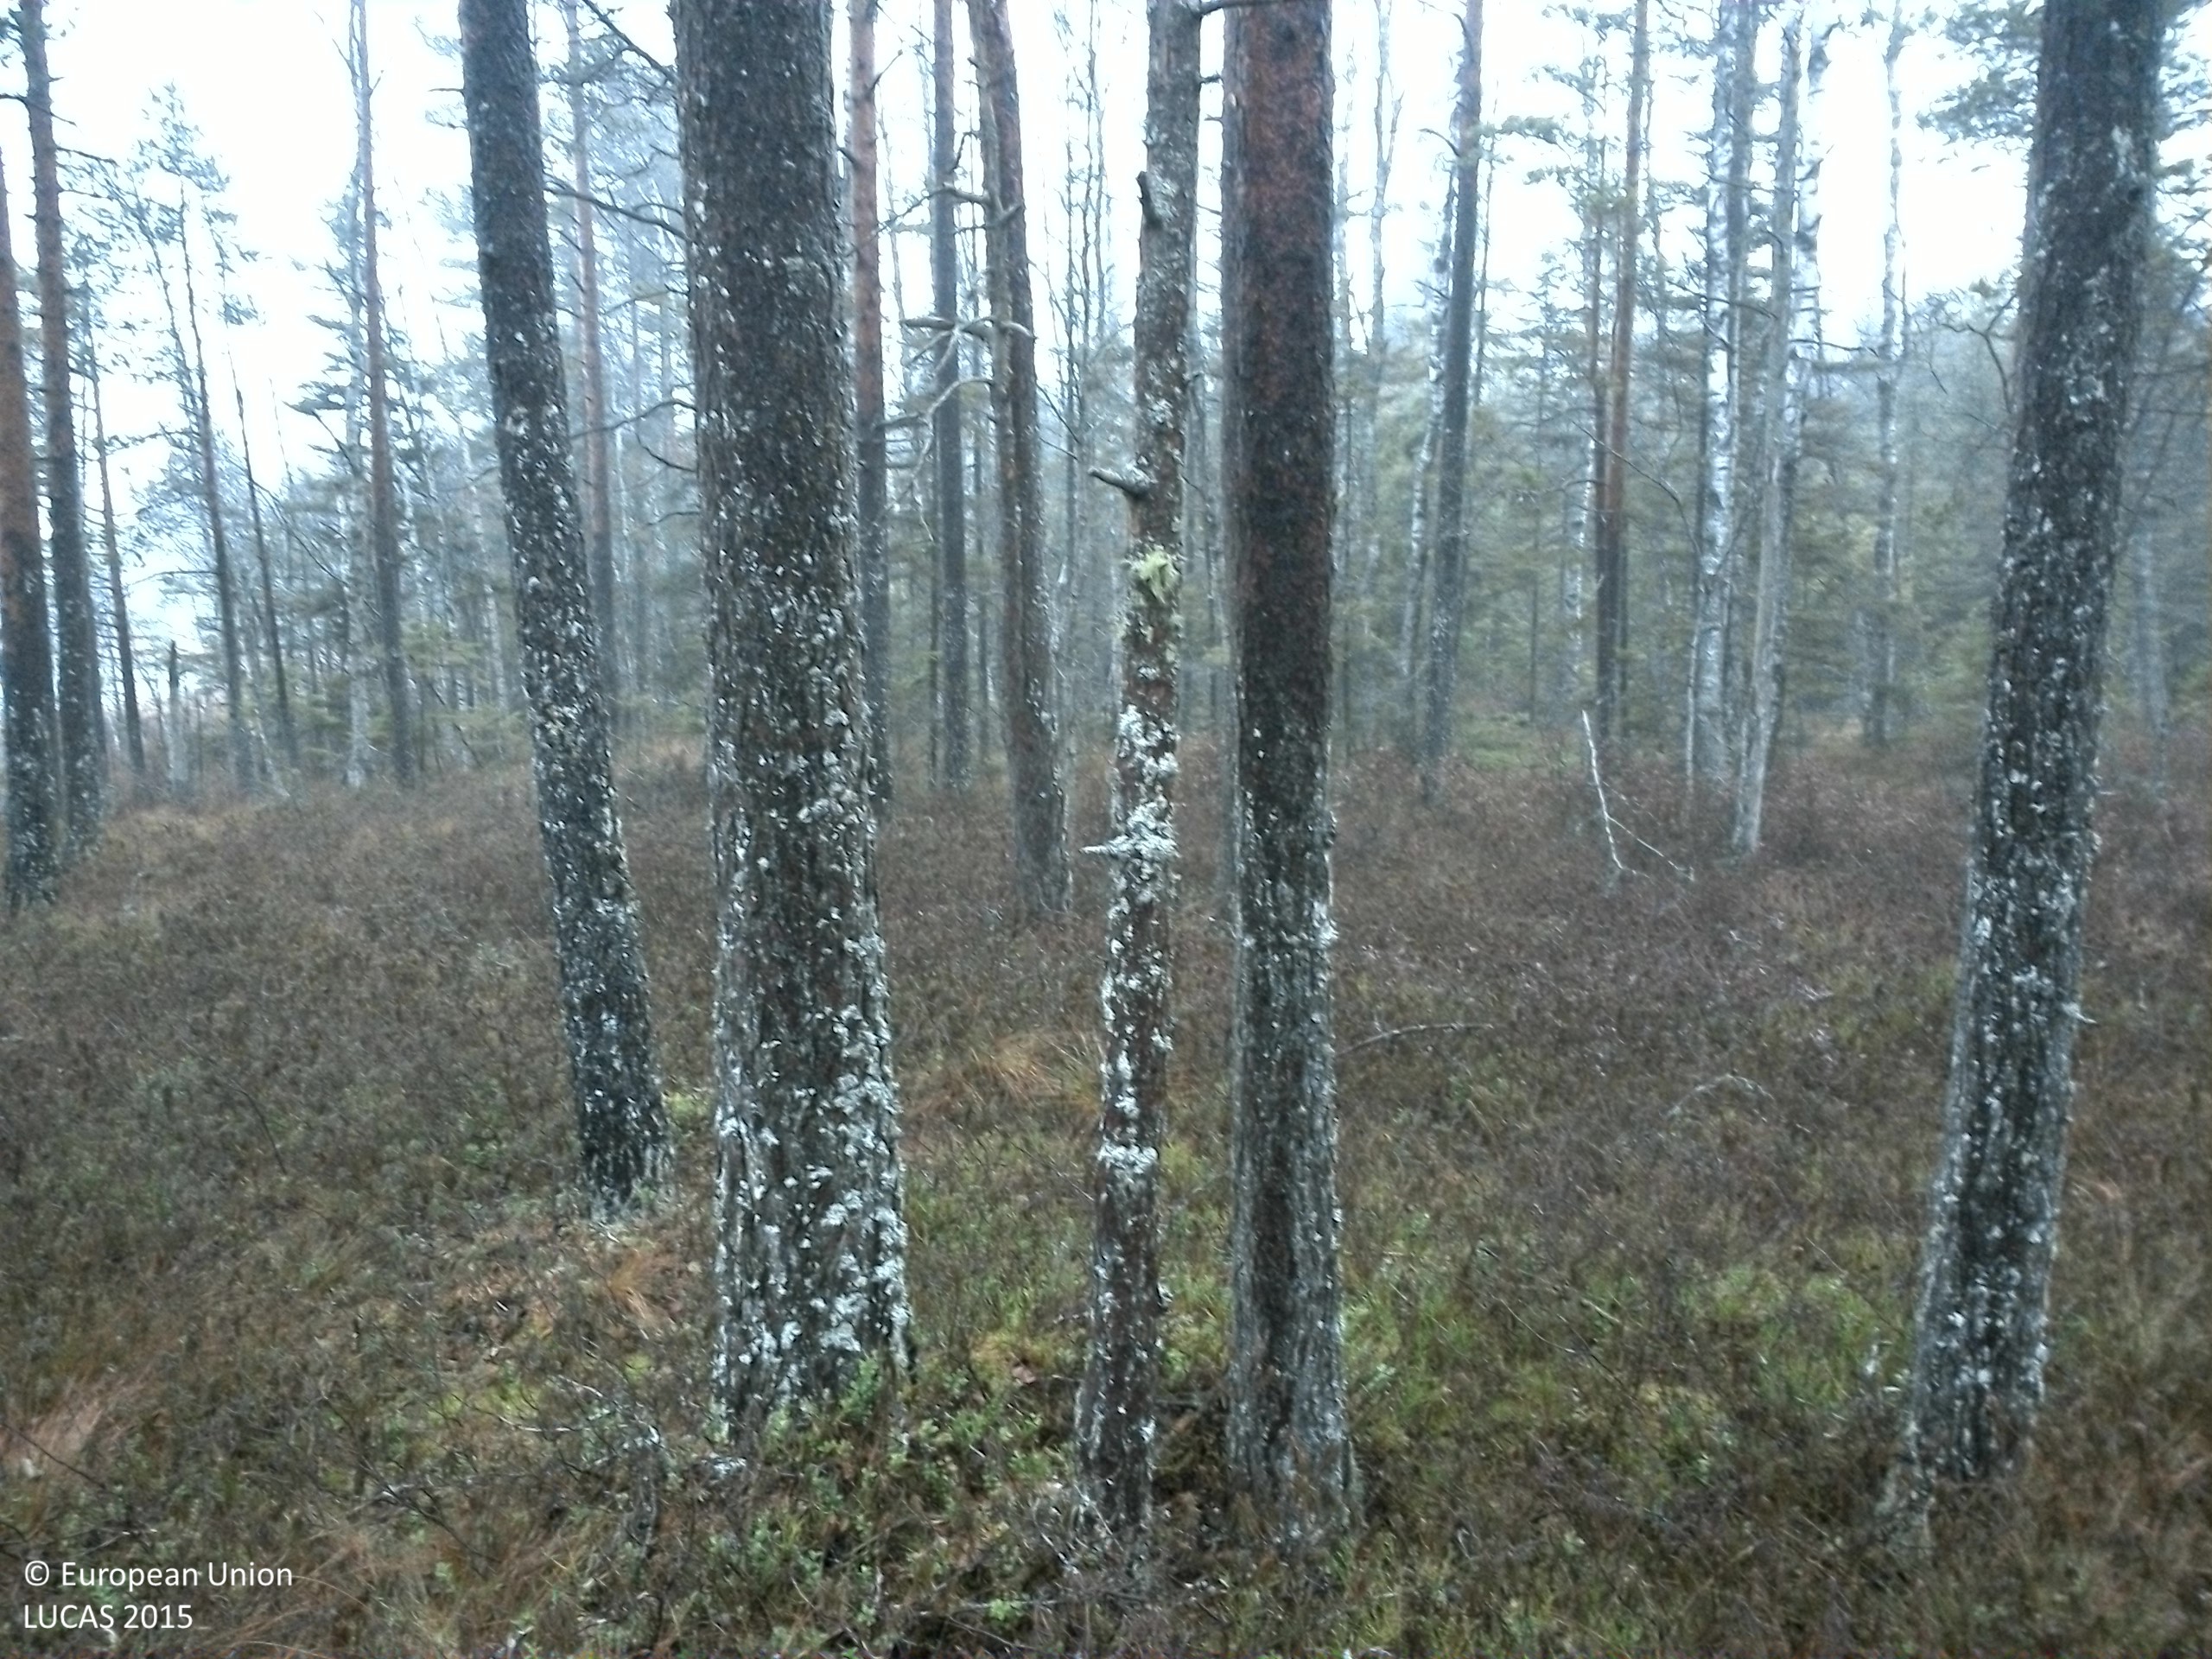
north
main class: Woodland
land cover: Pine dominated coniferous woodland
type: mire and swamp forests
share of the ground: 50 - 75 %
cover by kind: coniferous forest trees 60 %, shrubs 20 %, lichens and mosses 20 %
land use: Forestry
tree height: > 5 m
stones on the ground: < 10 %
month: November
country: SE
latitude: 57.7051
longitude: 15.1813
